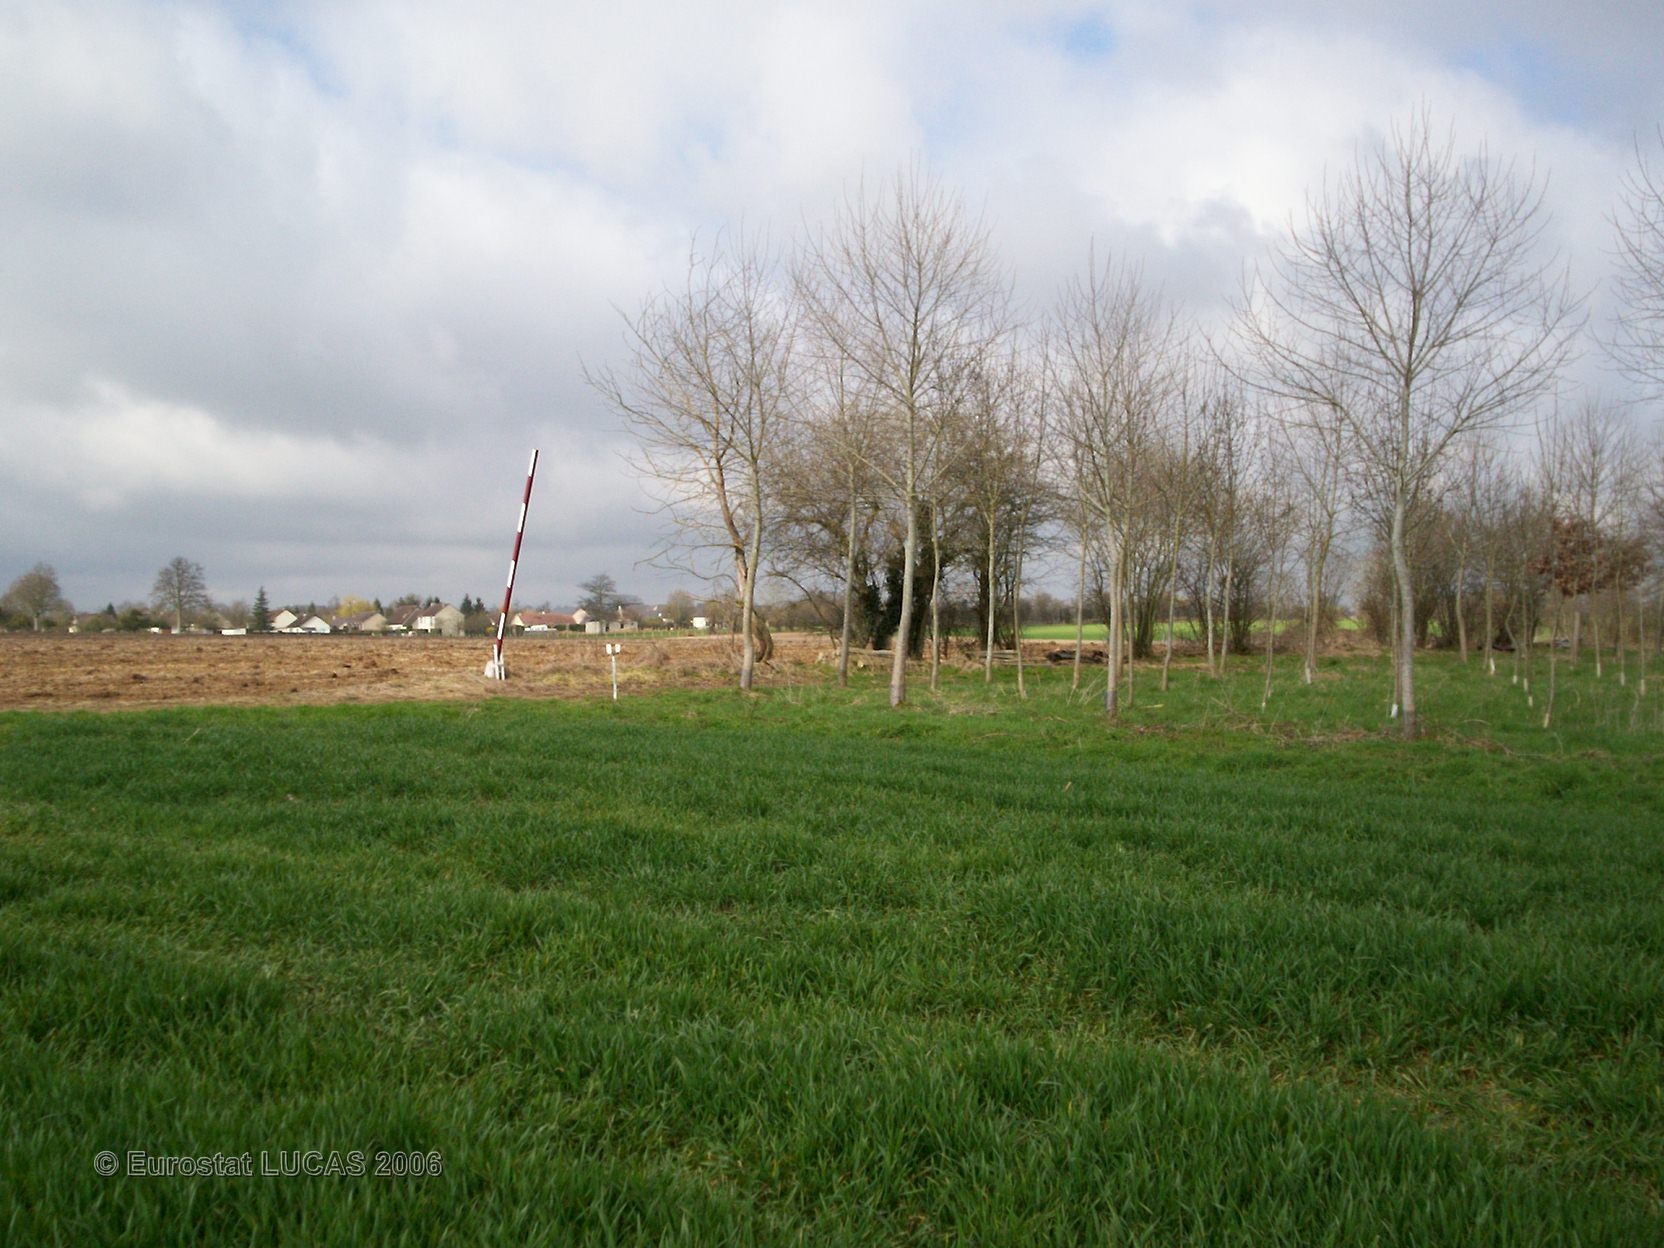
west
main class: Cropland
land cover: Triticale
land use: Agriculture (excluding fallow land and kitchen gardens)
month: April
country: FR
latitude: 48.8321
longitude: 0.5615
